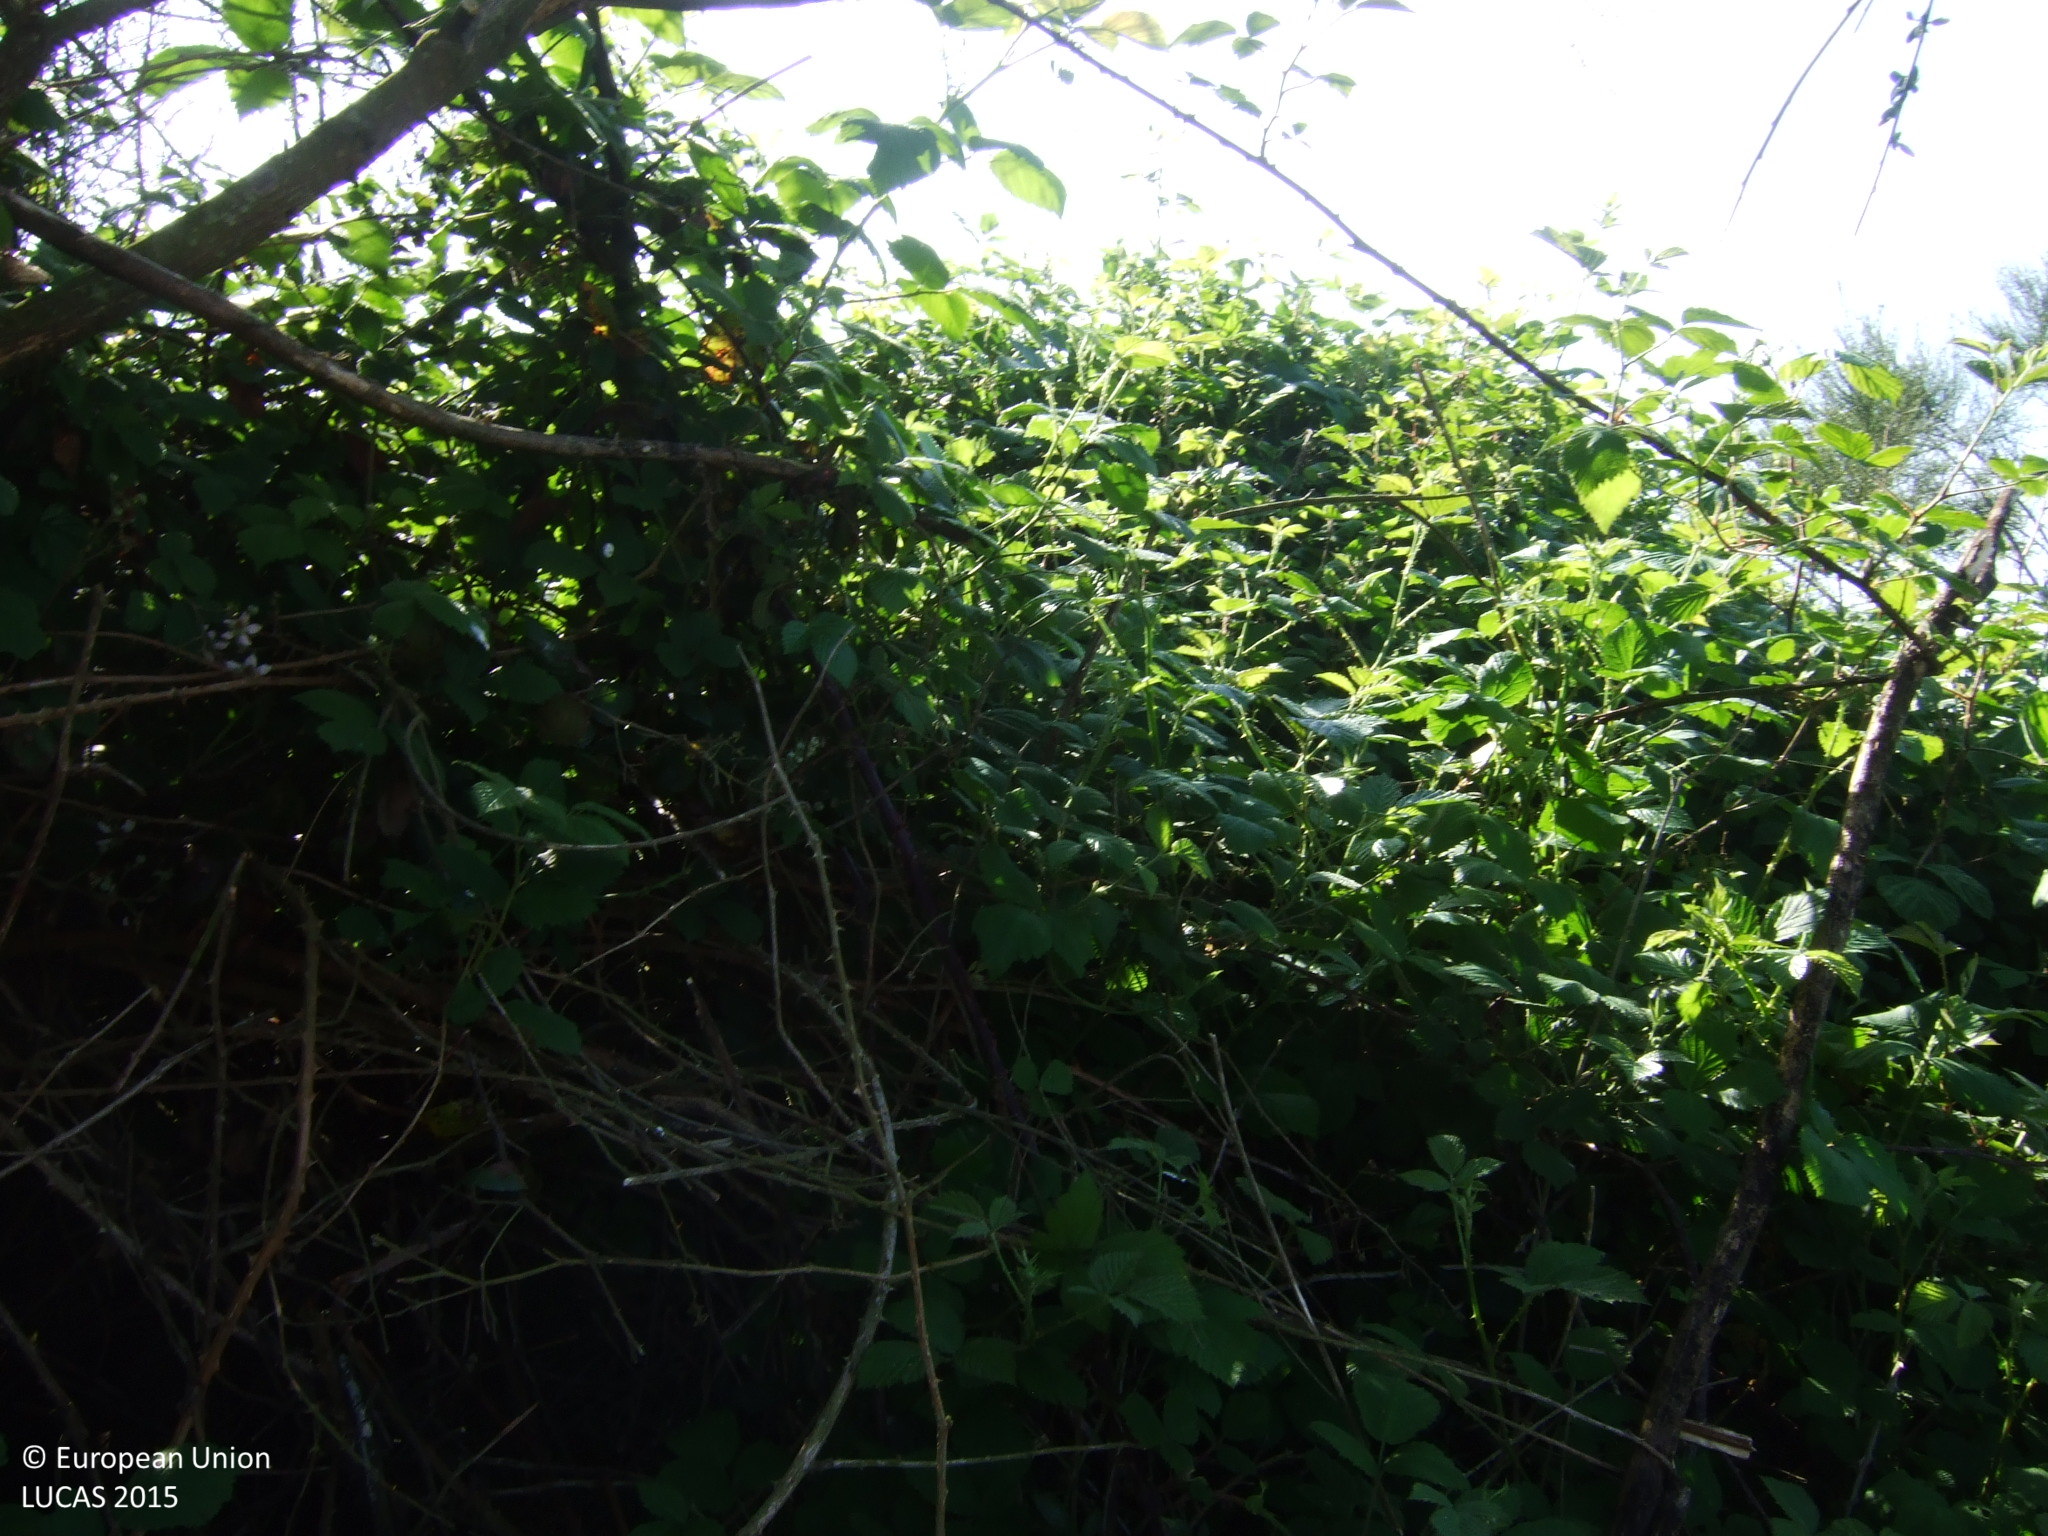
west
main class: Shrubland
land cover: Shrubland with sparse tree cover
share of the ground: > 75 %
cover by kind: shrubs 95 %, broadleaved forest trees 5 %
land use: Abandoned areas
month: May
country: ES
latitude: 43.0865
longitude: -7.4067
